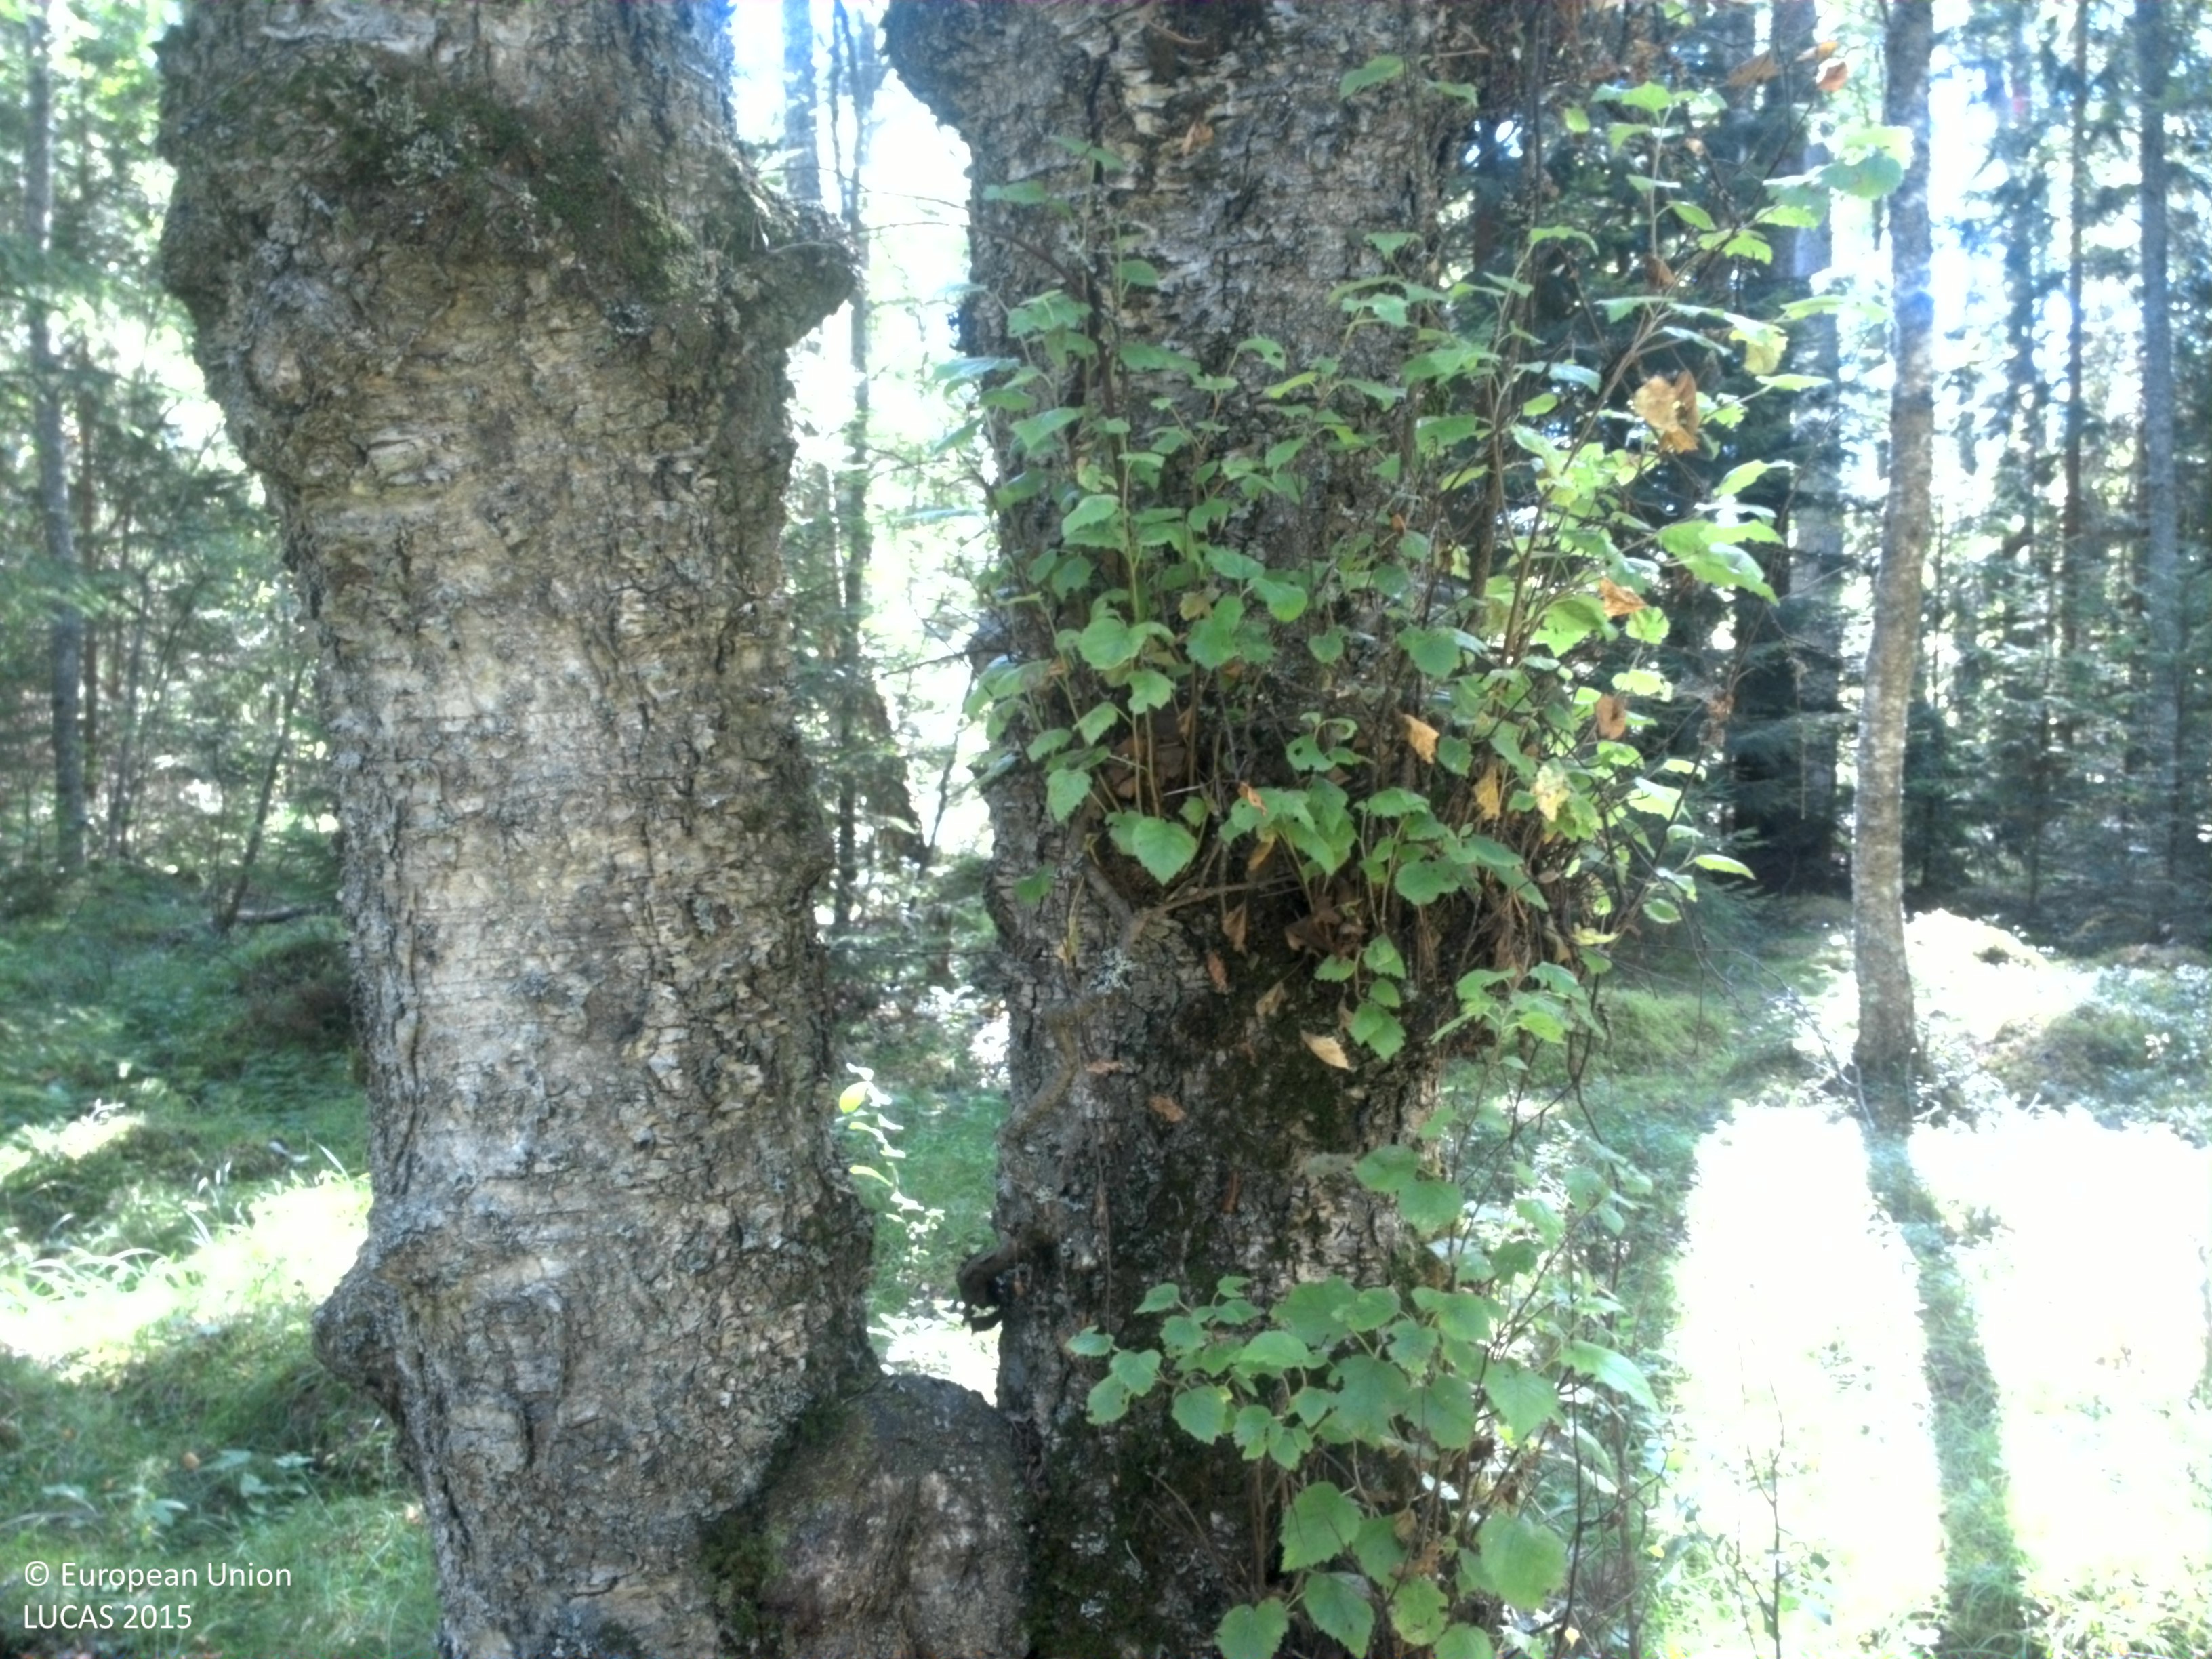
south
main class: Woodland
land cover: Pine dominated mixed woodland
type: boreal forest
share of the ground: 50 - 75 %
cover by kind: coniferous forest trees 30 %, herbaceous plants 25 %, broadleaved forest trees 20 %, lichens and mosses 15 %, shrubs 10 %
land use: Forestry
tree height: > 5 m
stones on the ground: > 50 %
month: August
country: SE
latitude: 58.0718
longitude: 13.2668
